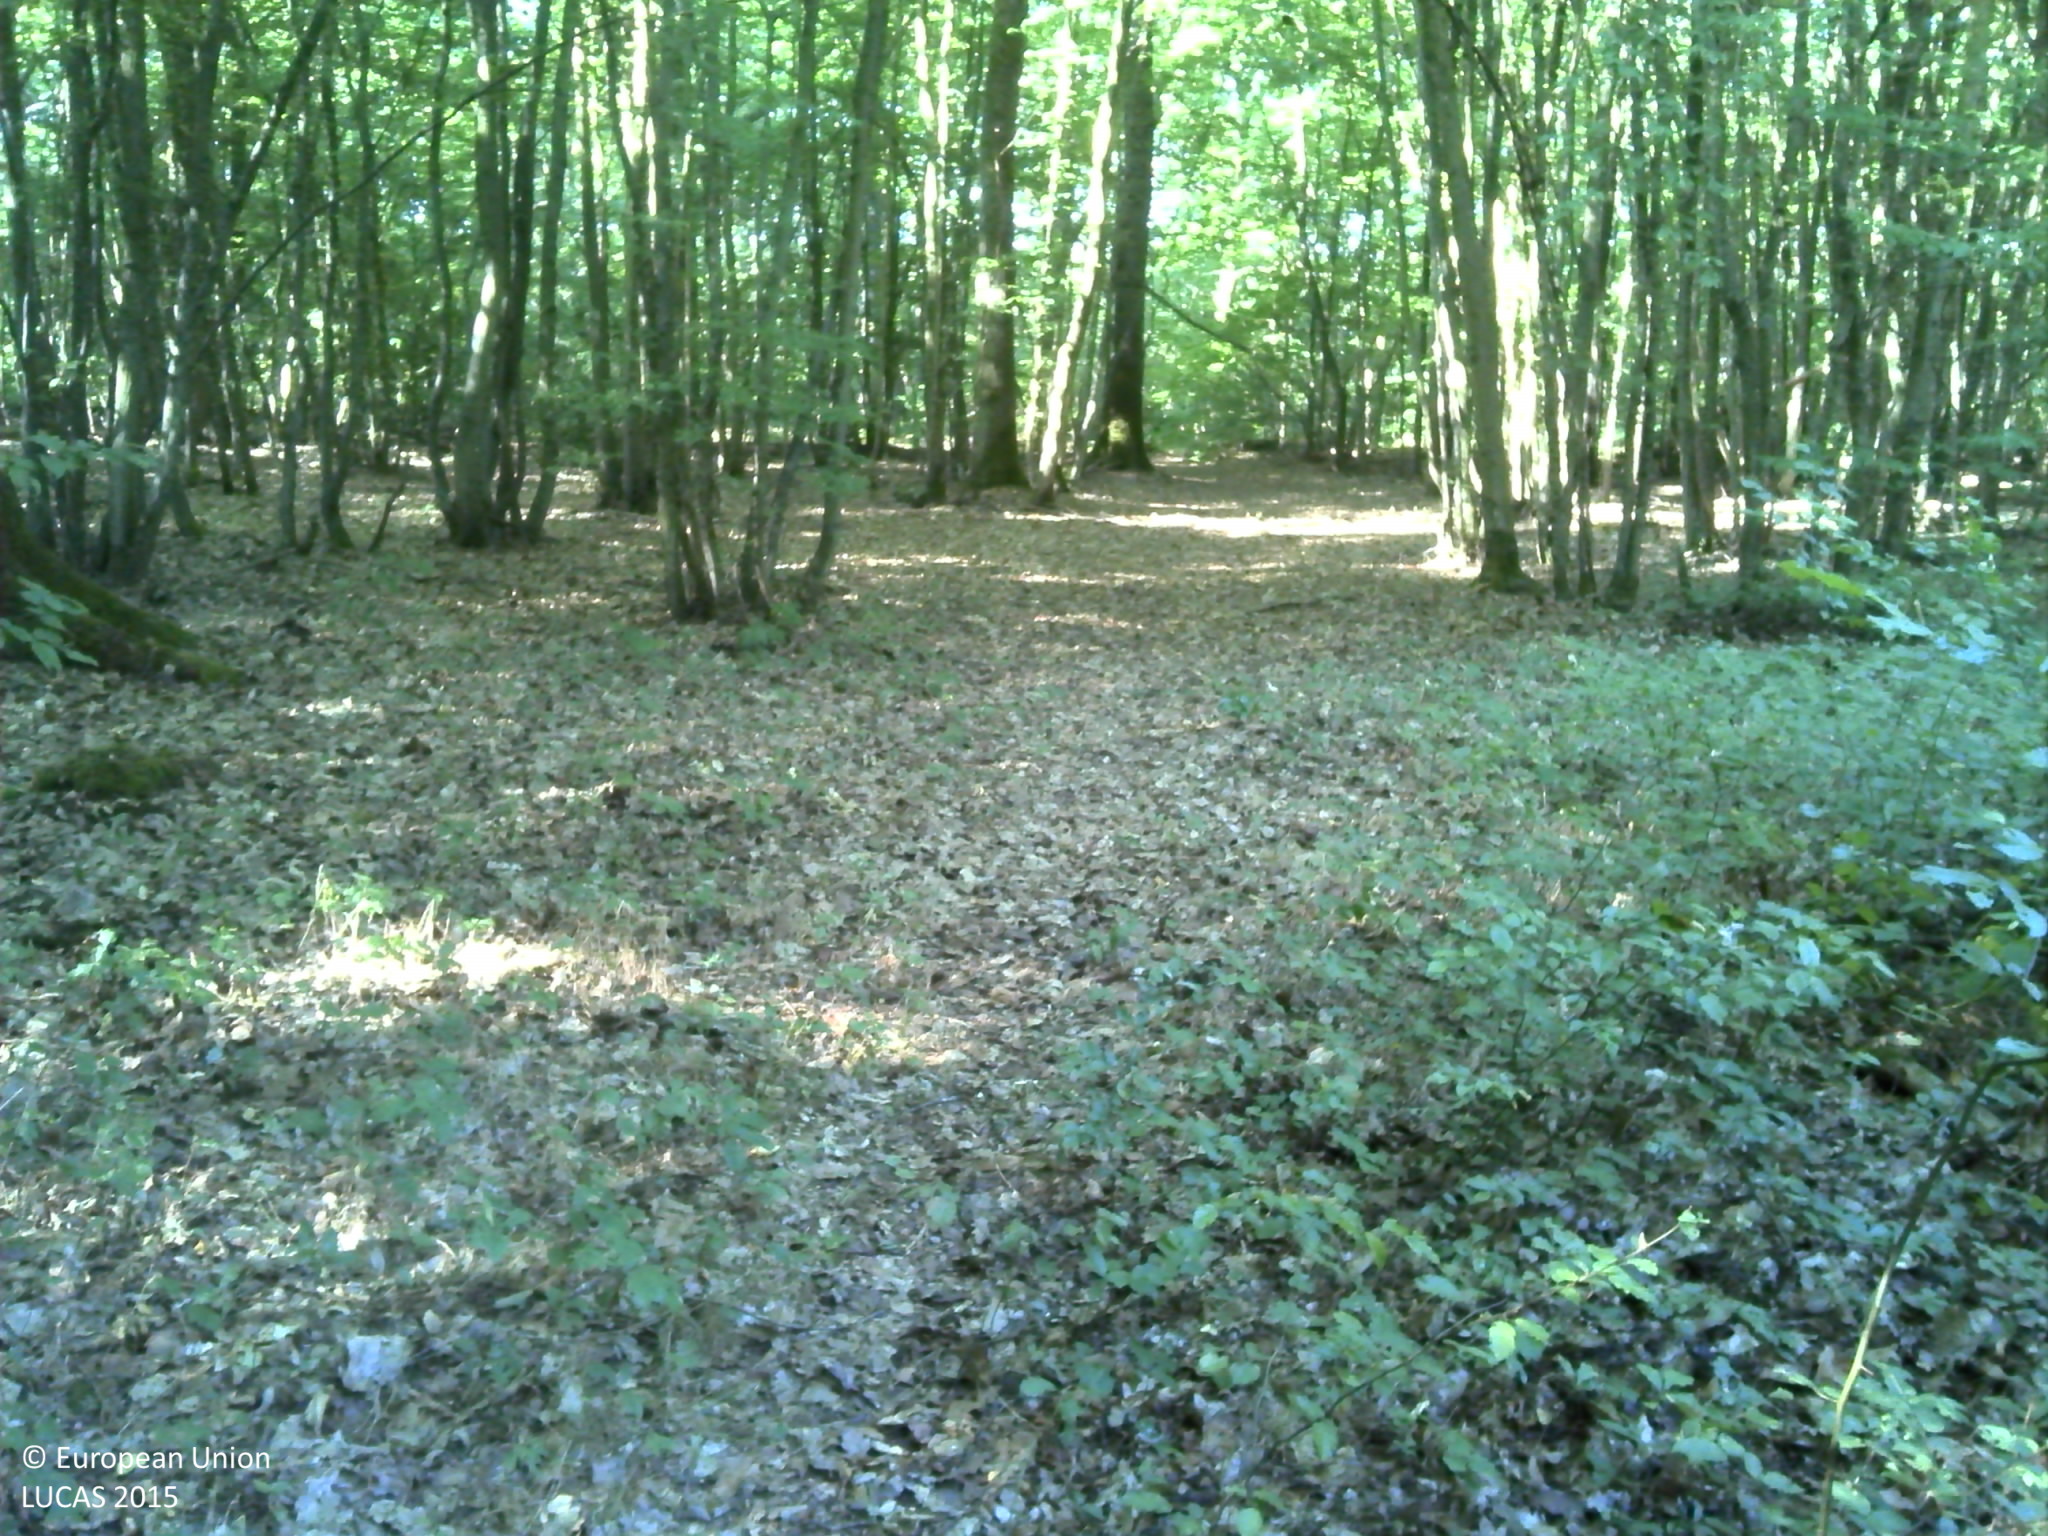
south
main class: Woodland
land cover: Broadleaved woodland
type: mesophytic deciduous forest
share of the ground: > 75 %
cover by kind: broadleaved forest trees 80 %, shrubs 15 %, herbaceous plants 5 %
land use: Forestry
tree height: > 5 m
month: August
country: FR
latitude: 48.7166
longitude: 1.8436
